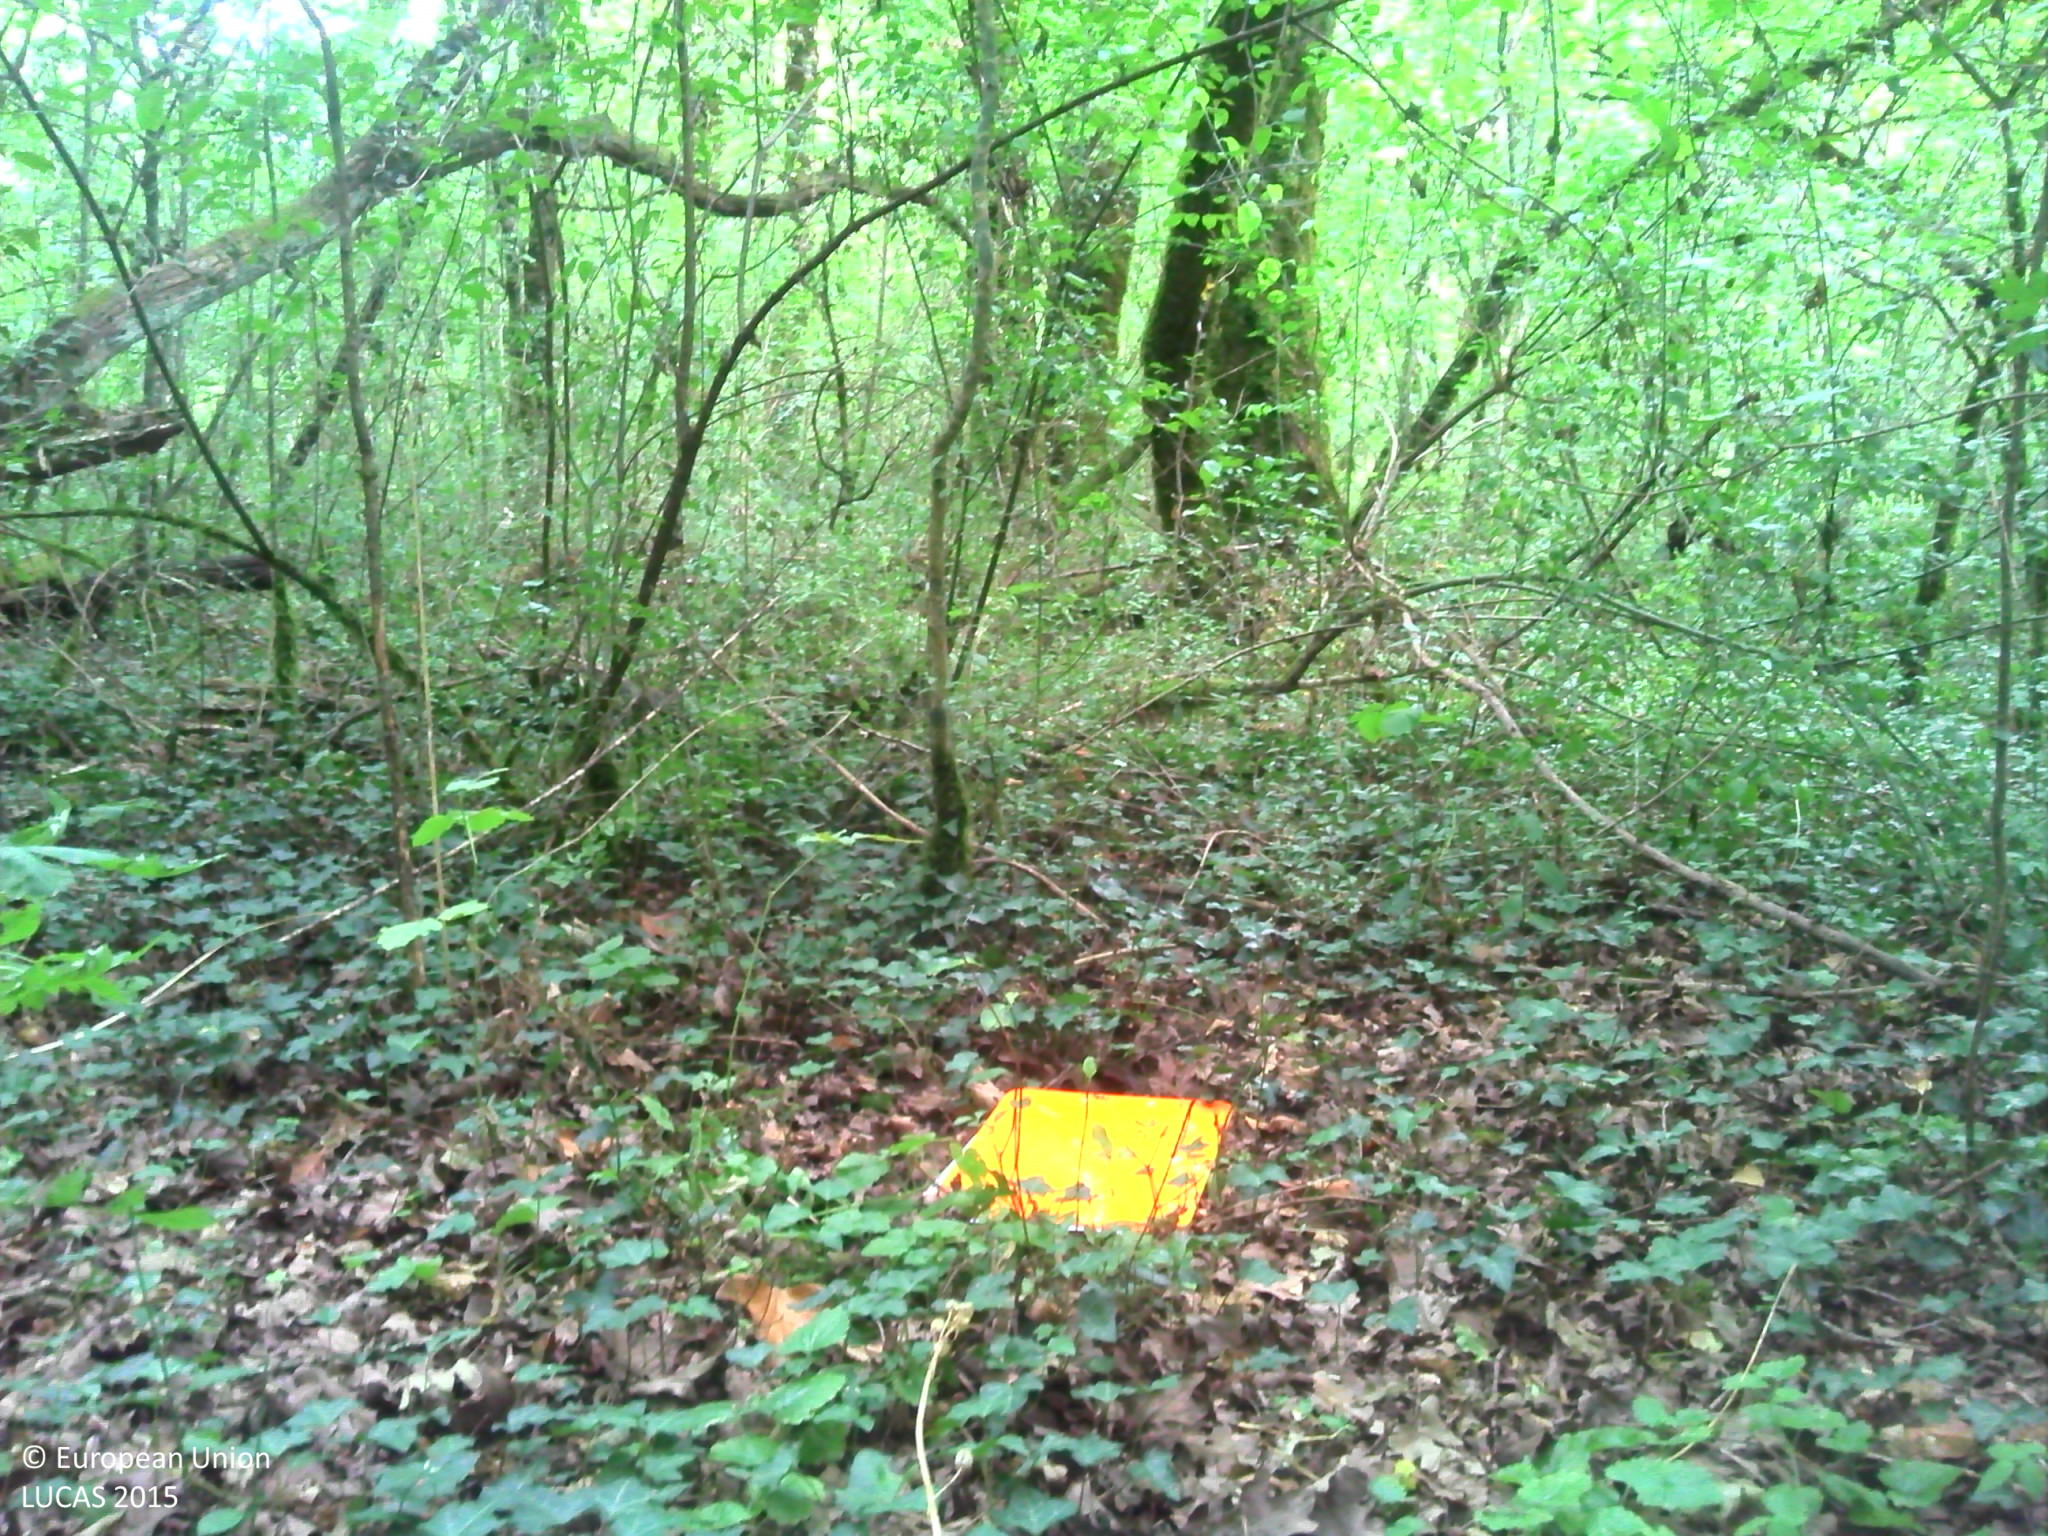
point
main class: Woodland
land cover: Broadleaved woodland
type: mesophytic deciduous forest
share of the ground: > 75 %
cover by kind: broadleaved forest trees 90 %, shrubs 5 %, herbaceous plants 5 %
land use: Forestry
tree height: > 5 m
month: July
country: FR
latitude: 45.7668
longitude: 5.4393
